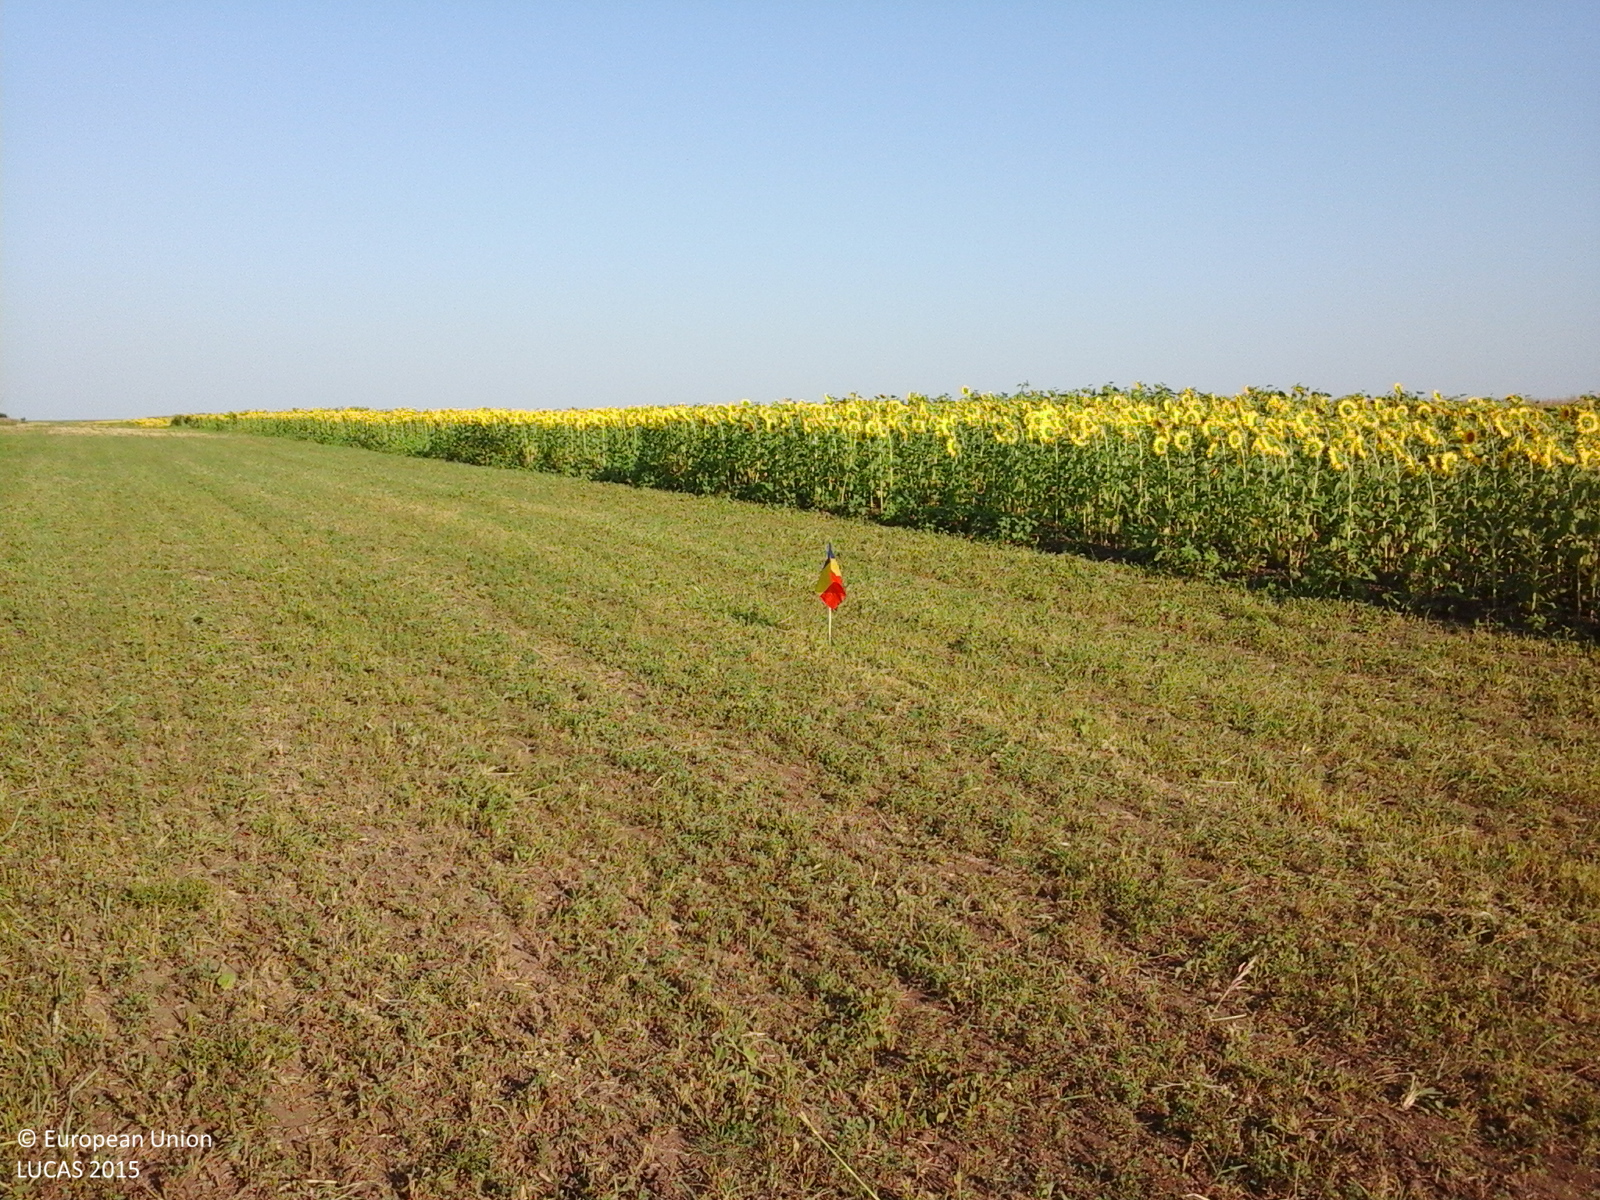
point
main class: Cropland
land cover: Lucerne
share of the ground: > 75 %
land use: Agriculture (excluding fallow land and kitchen gardens)
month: July
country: RO
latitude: 44.8120
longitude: 27.2212
